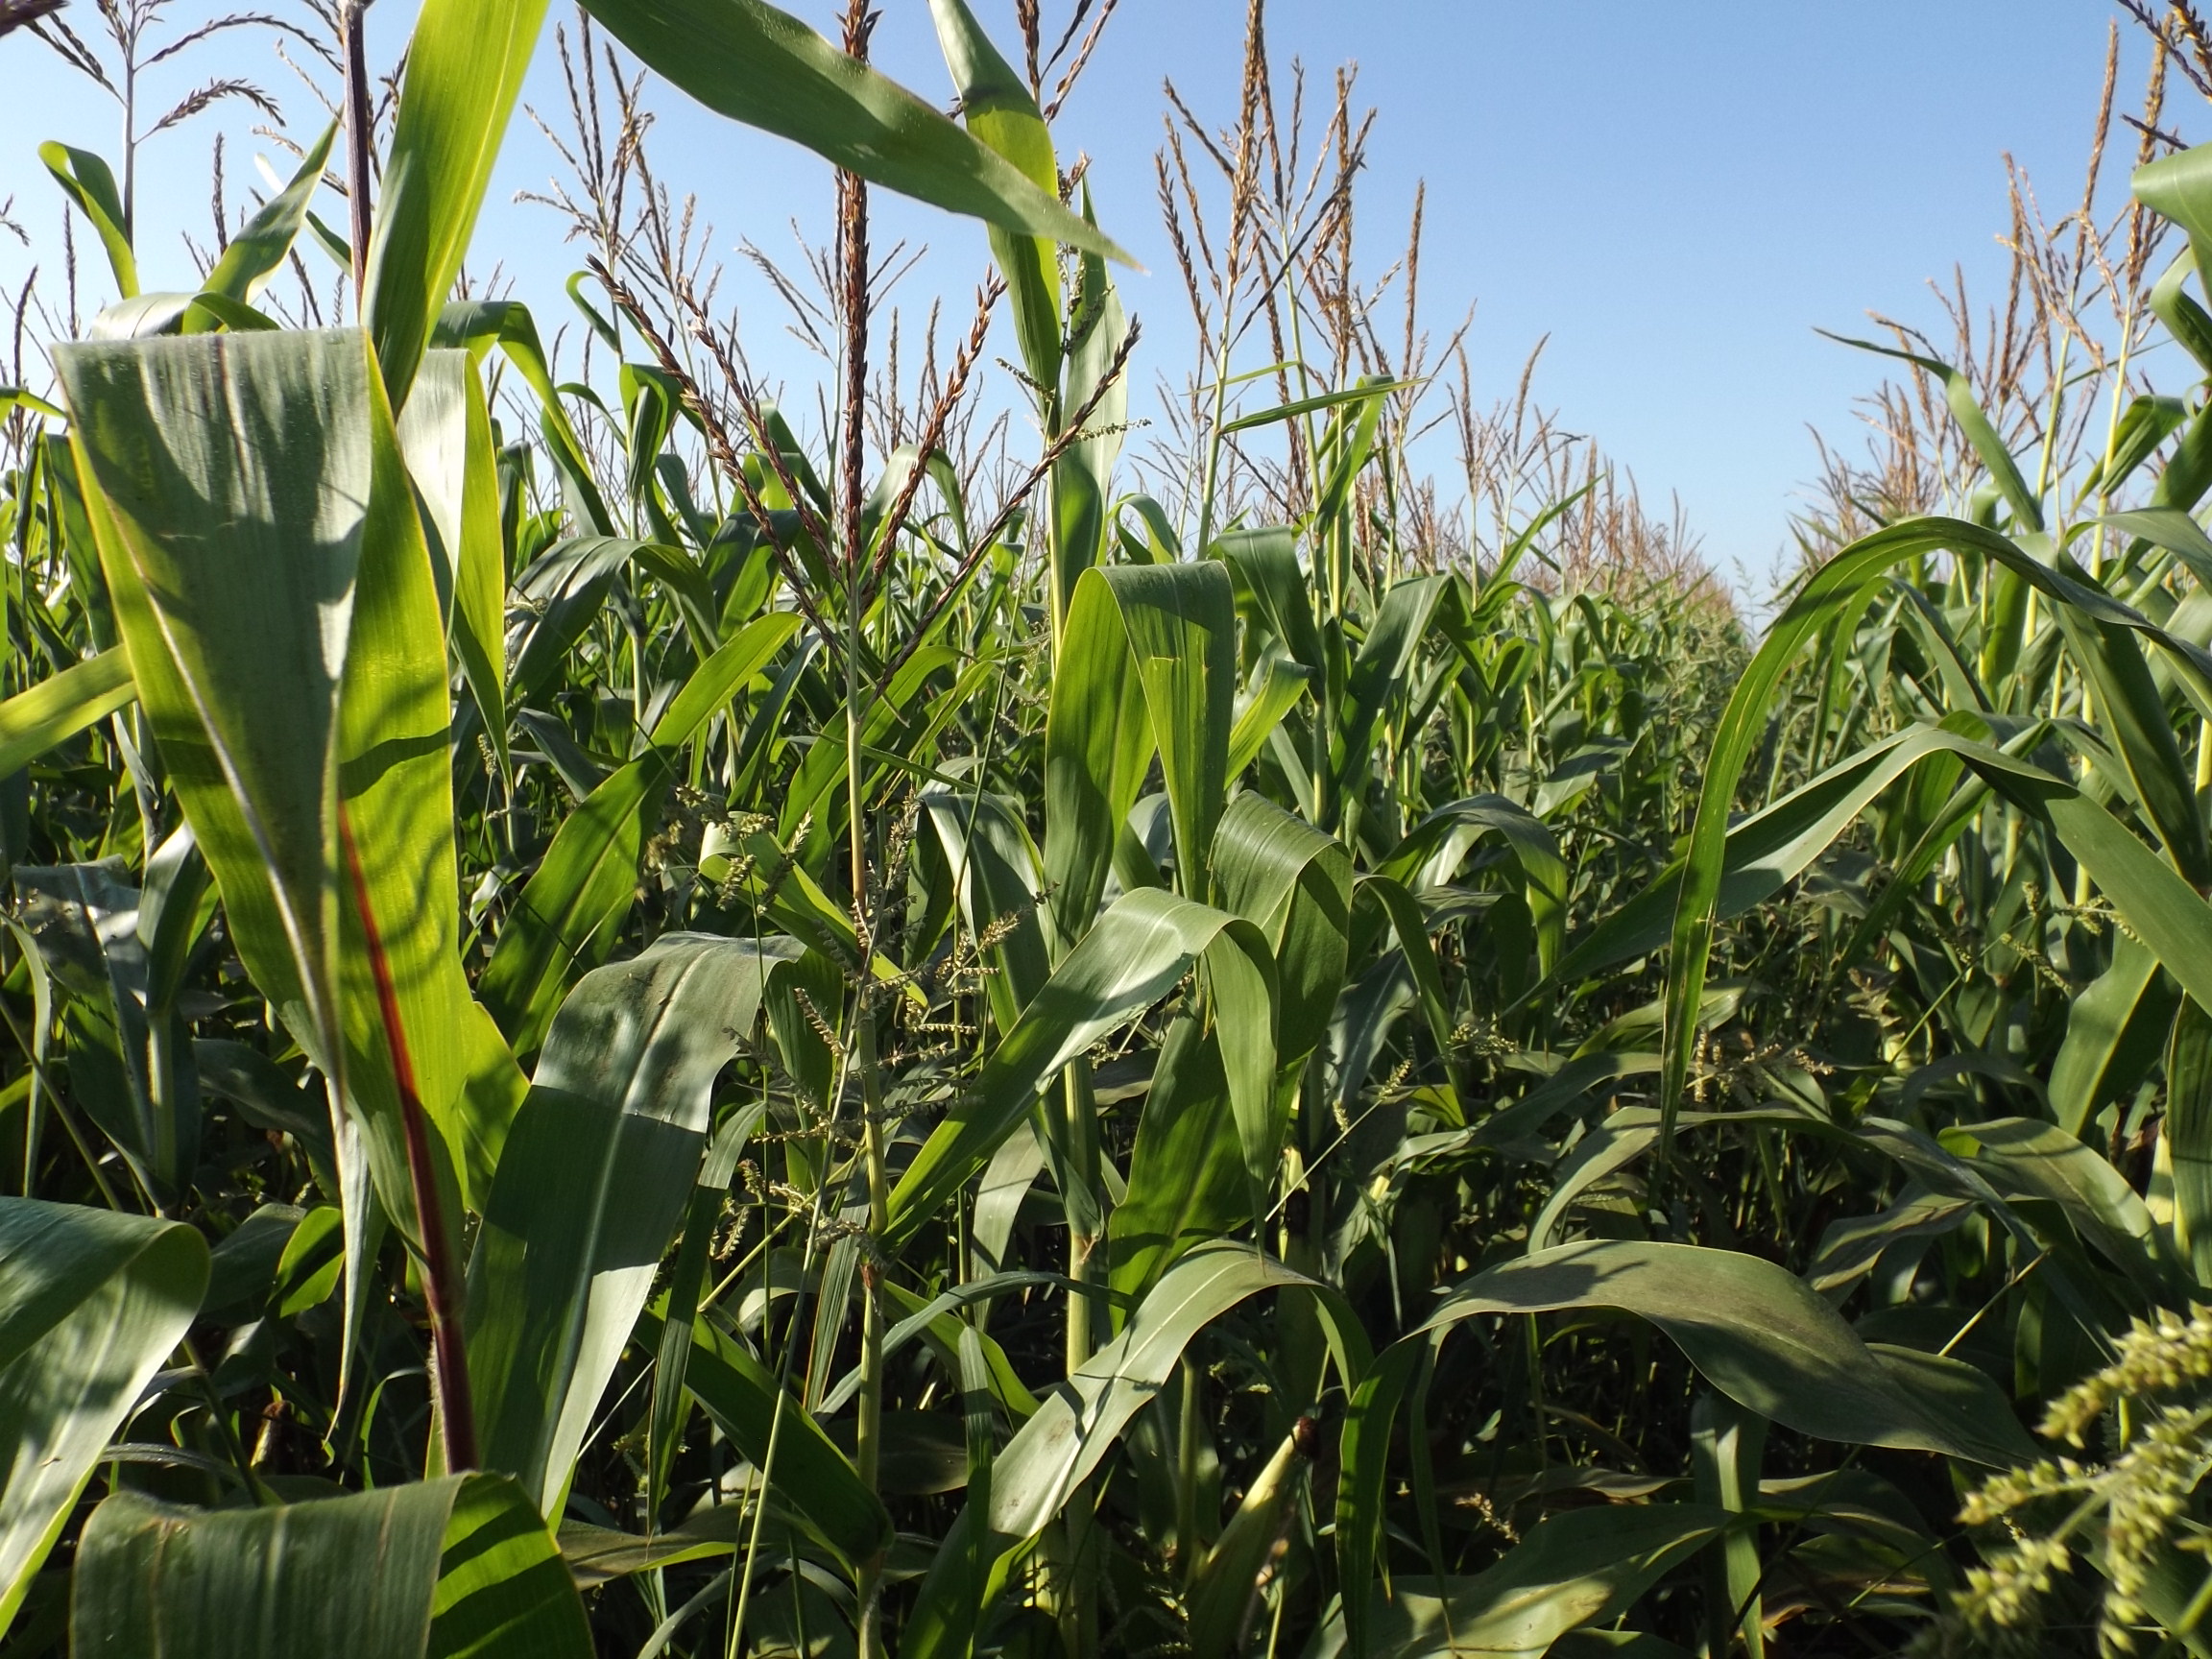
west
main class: Cropland
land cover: Maize
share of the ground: > 75 %
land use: Agriculture (excluding fallow land and kitchen gardens)
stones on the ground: < 10 %
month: August
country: BG
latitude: 43.3209
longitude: 27.9605
